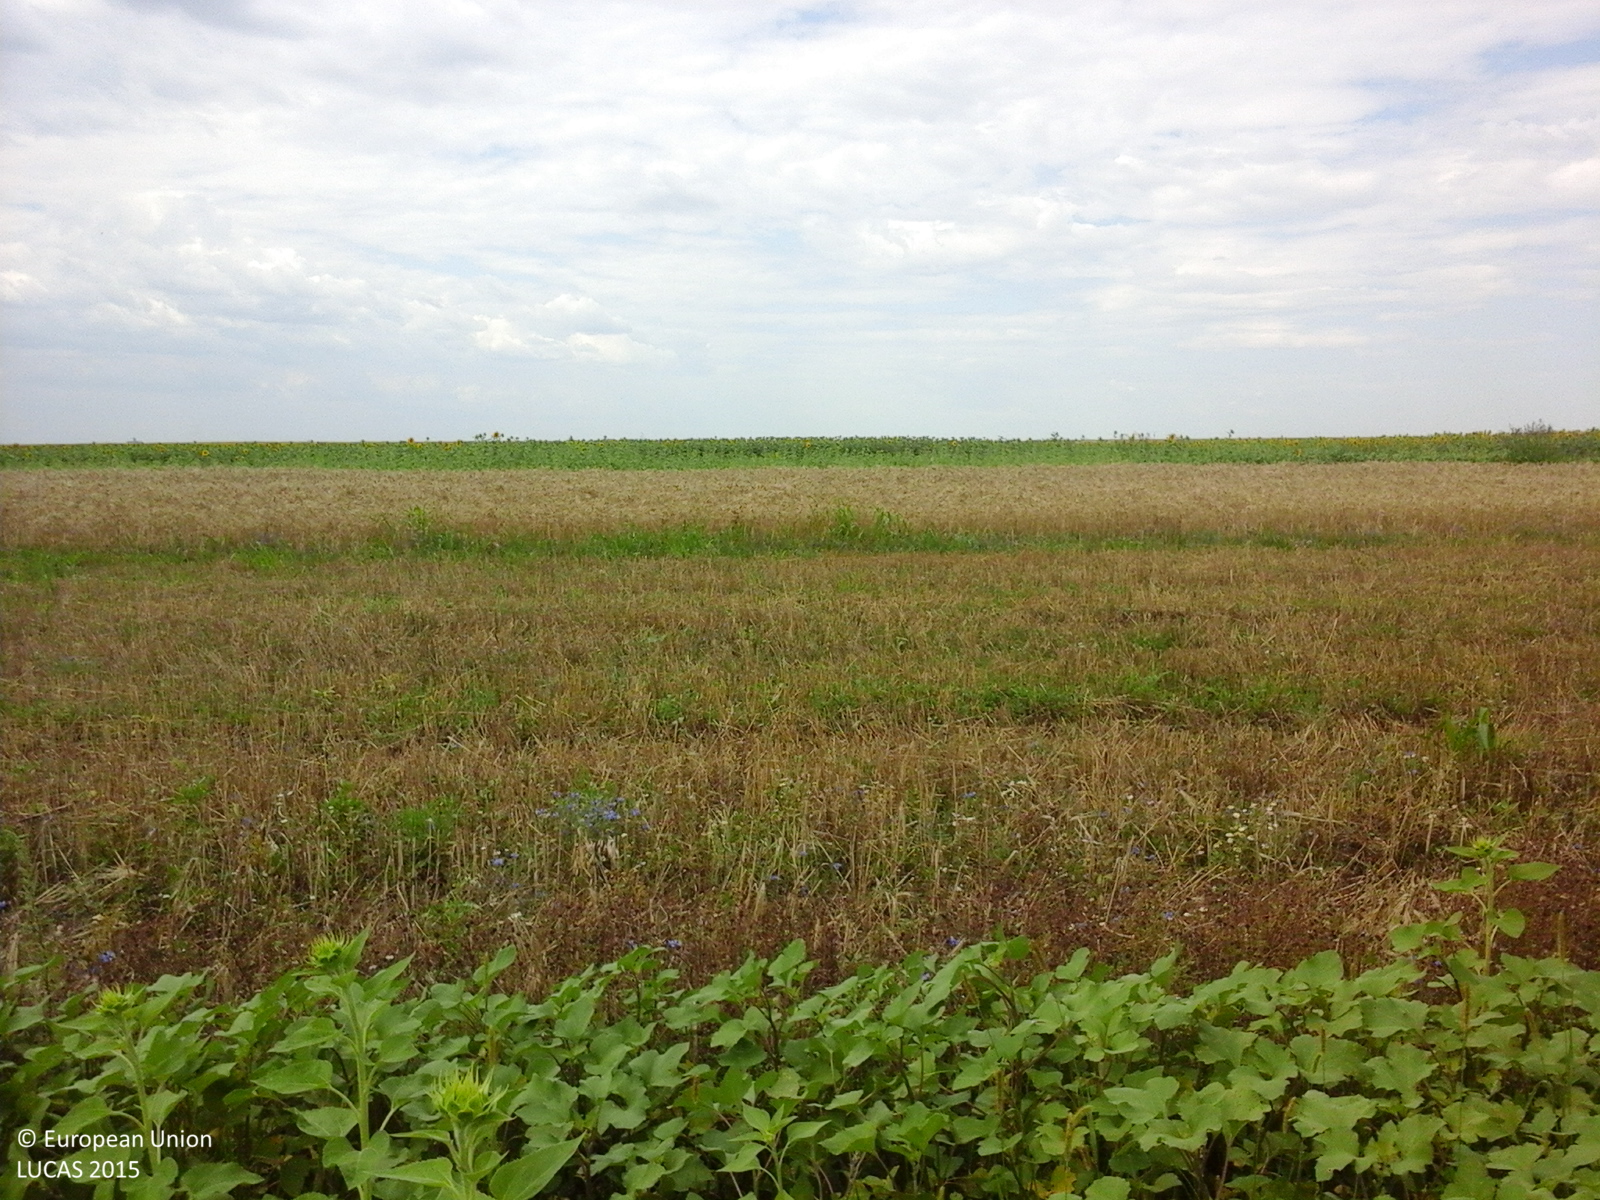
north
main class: Cropland
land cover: Sunflower
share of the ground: 25 - 50 %
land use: Agriculture (excluding fallow land and kitchen gardens)
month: July
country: RO
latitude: 44.0425
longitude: 24.7352
